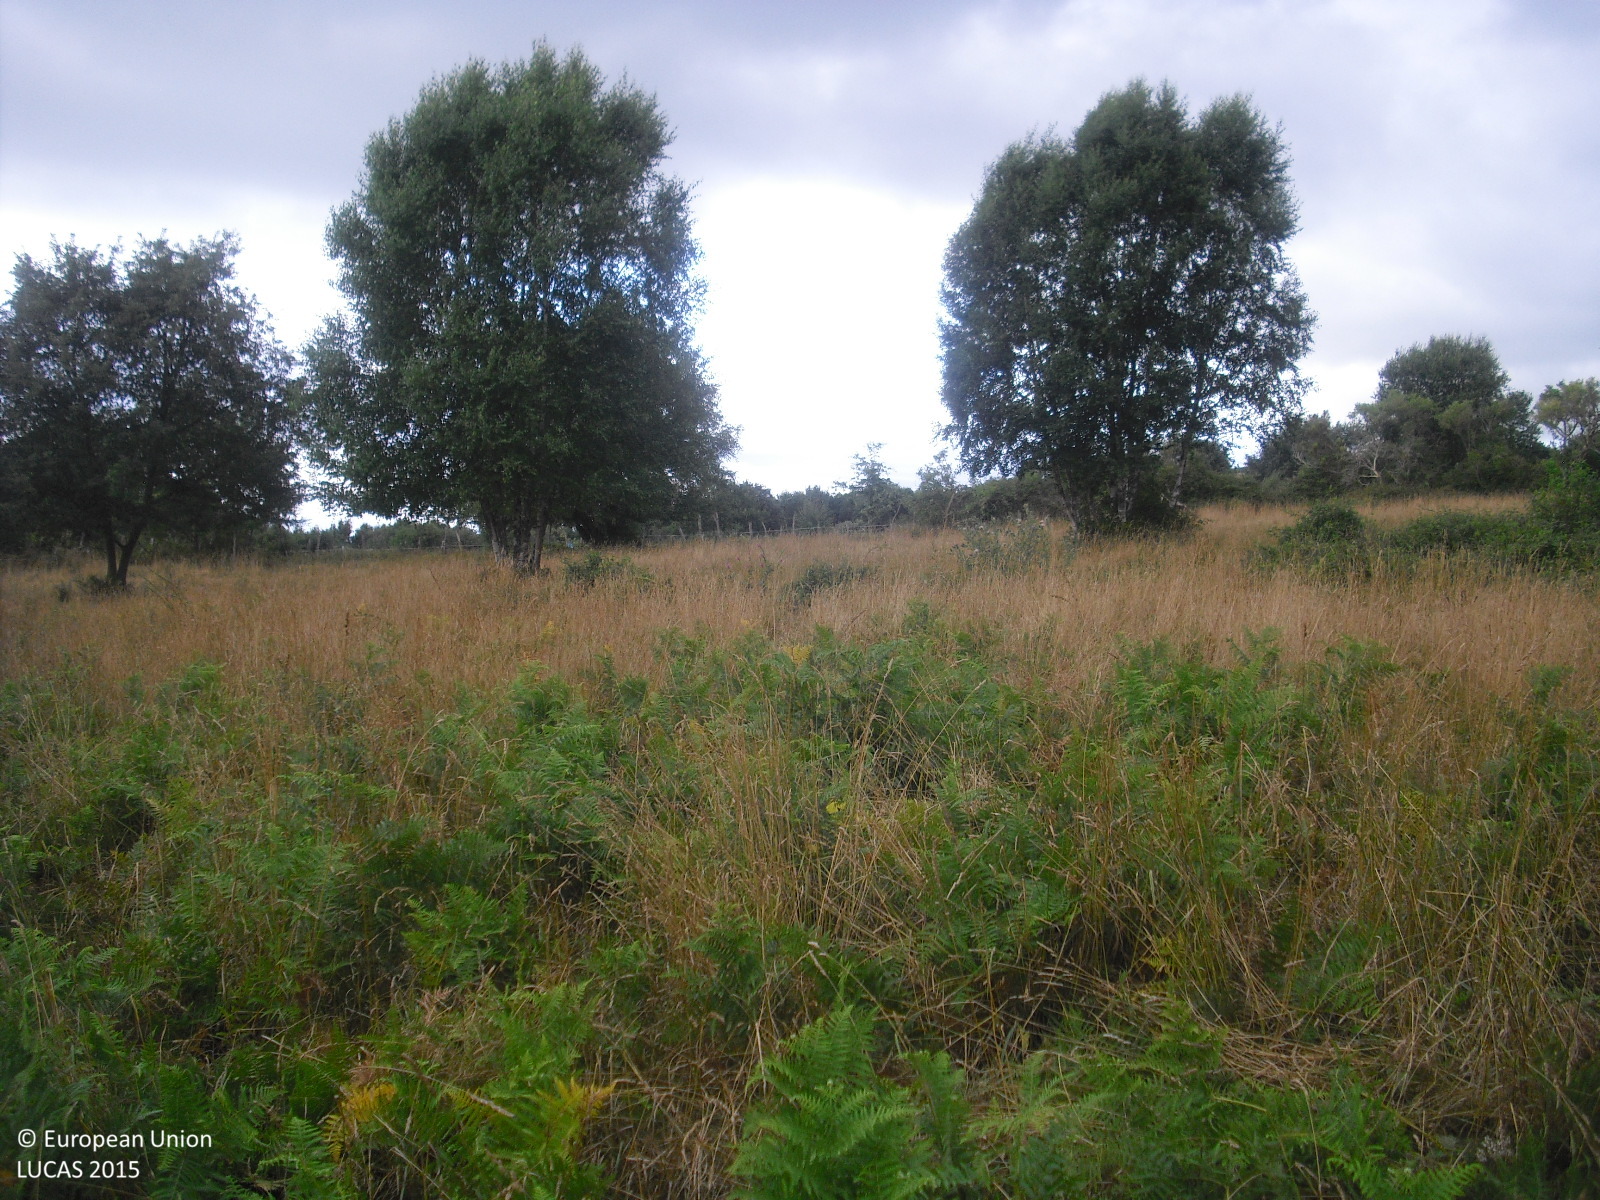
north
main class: Grassland
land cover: Grassland without tree/shrub cover
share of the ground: > 75 %
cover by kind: herbaceous plants 95 %, shrubs 5 %
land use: Agriculture (excluding fallow land and kitchen gardens)
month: July
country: ES
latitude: 42.3878
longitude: -7.3985
